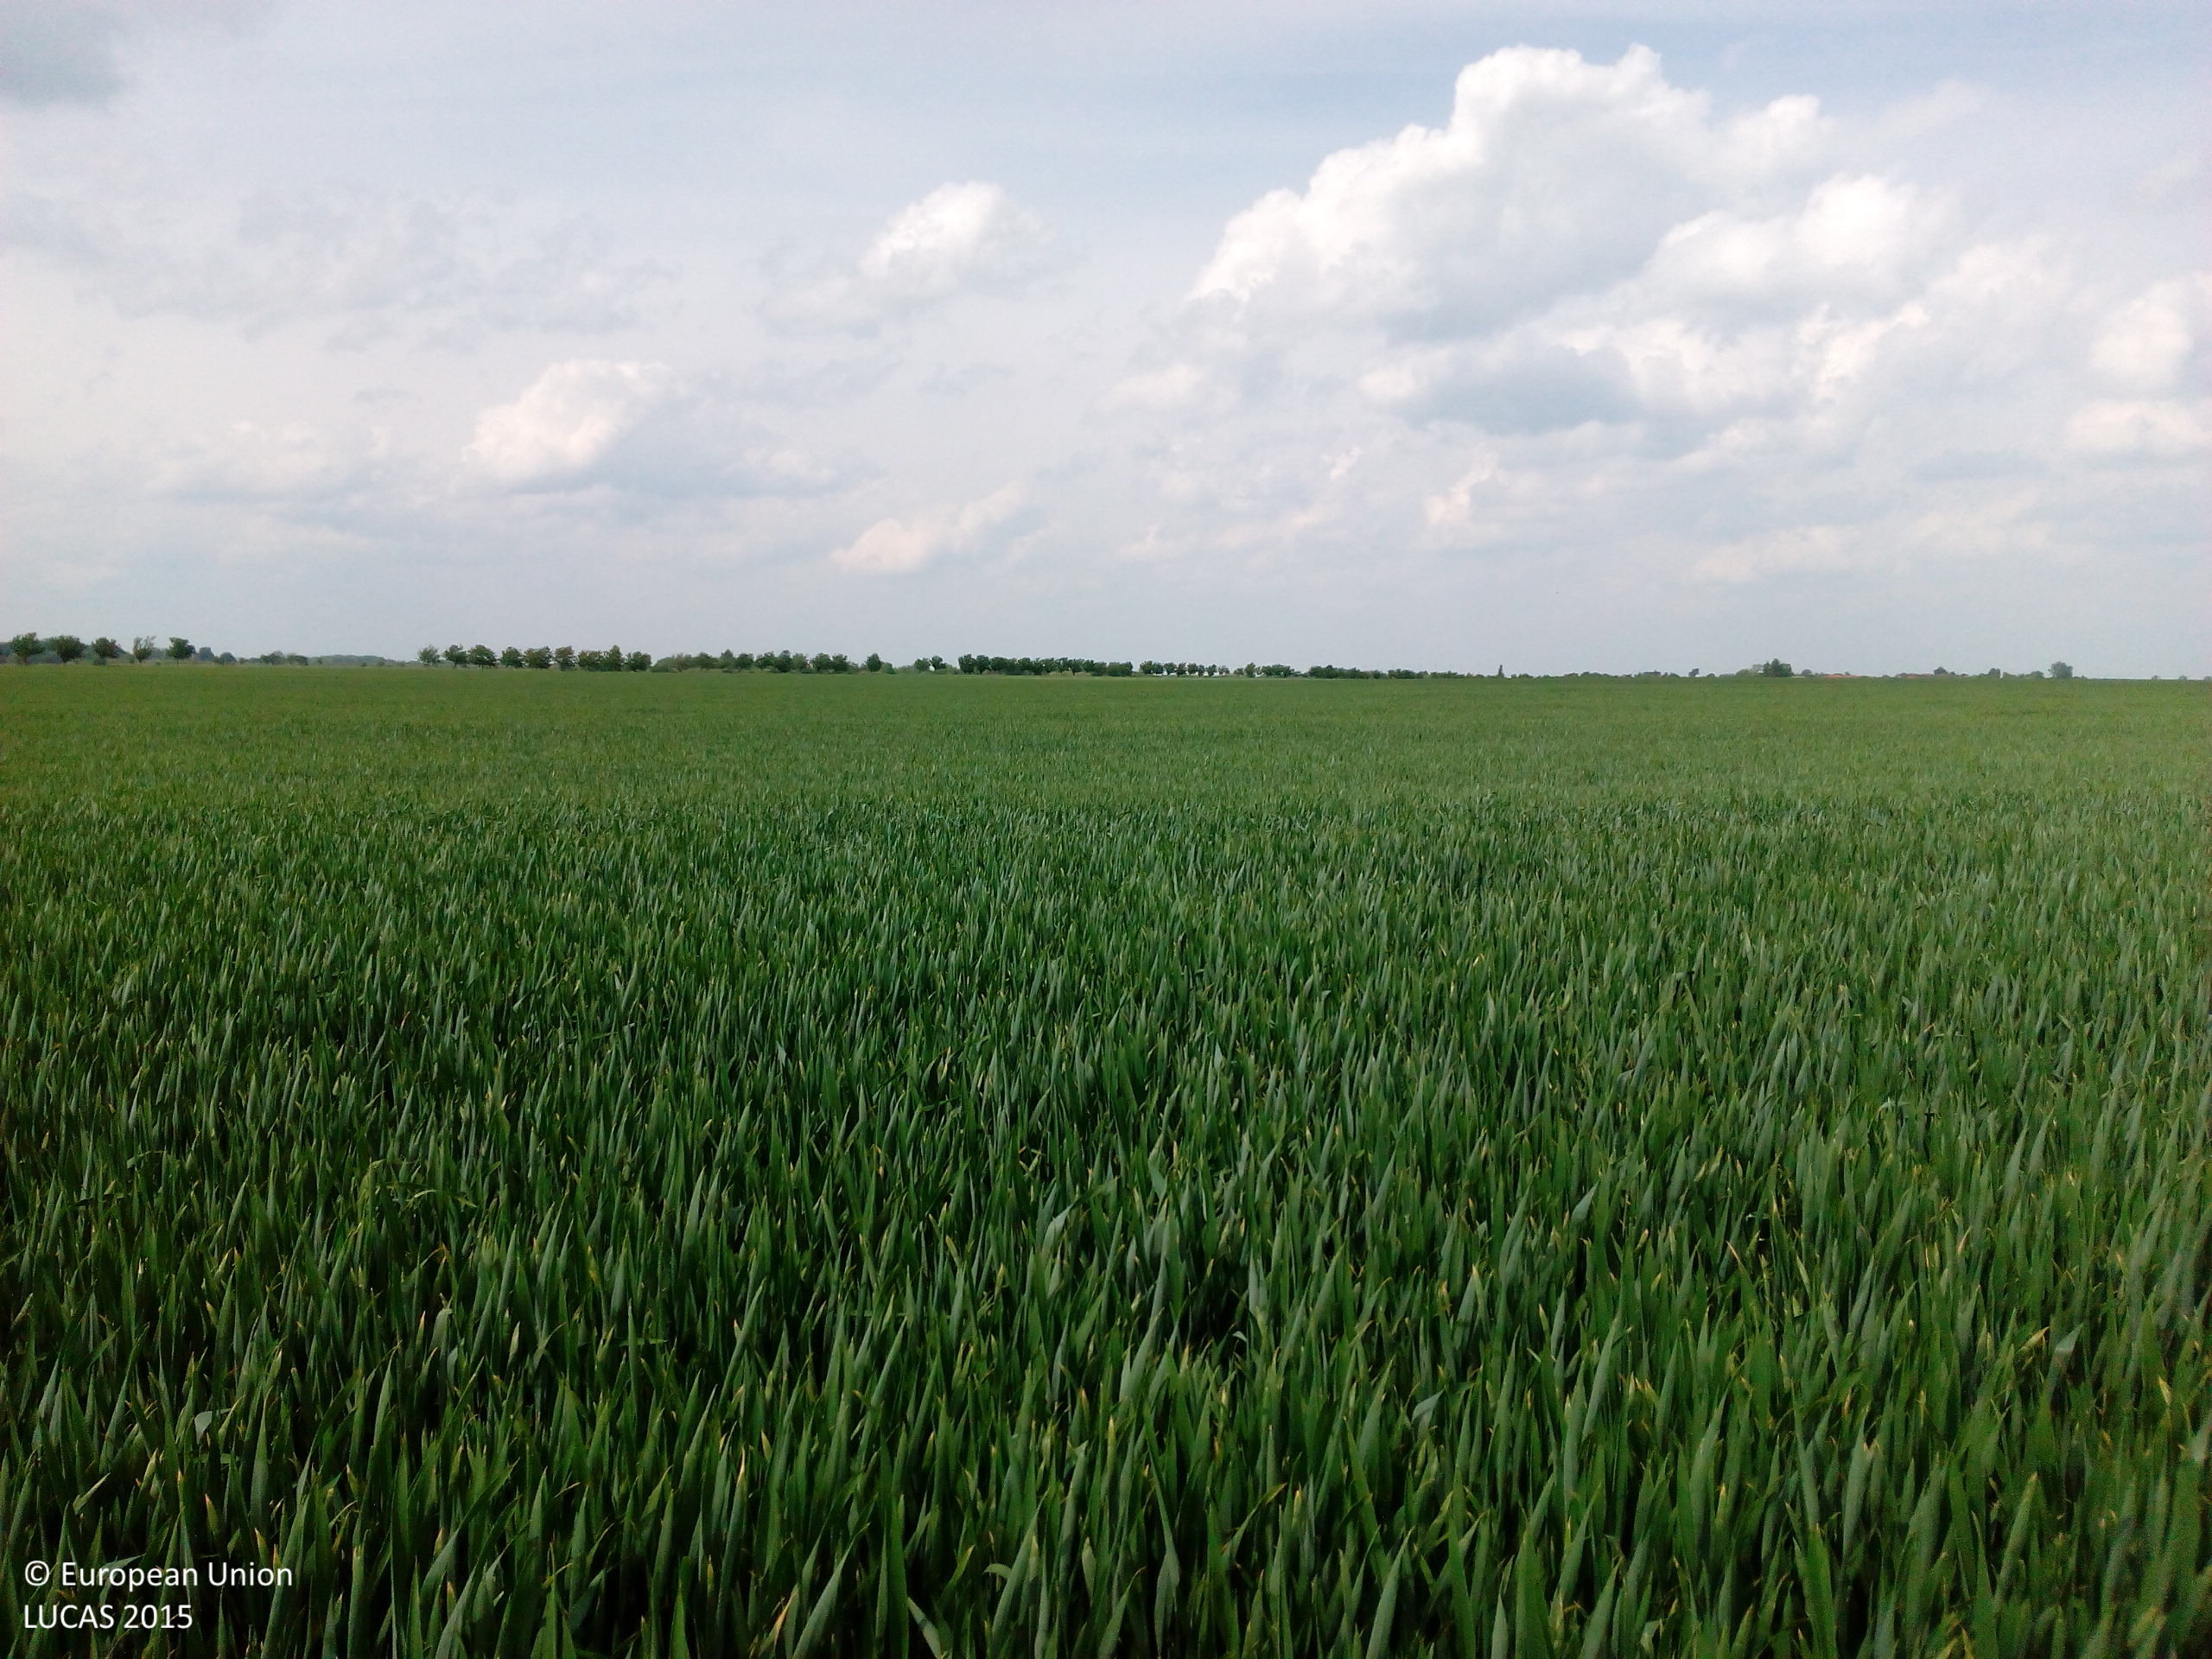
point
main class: Cropland
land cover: Common wheat
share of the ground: > 75 %
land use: Agriculture (excluding fallow land and kitchen gardens)
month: May
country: DE
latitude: 51.6757
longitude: 12.0965
